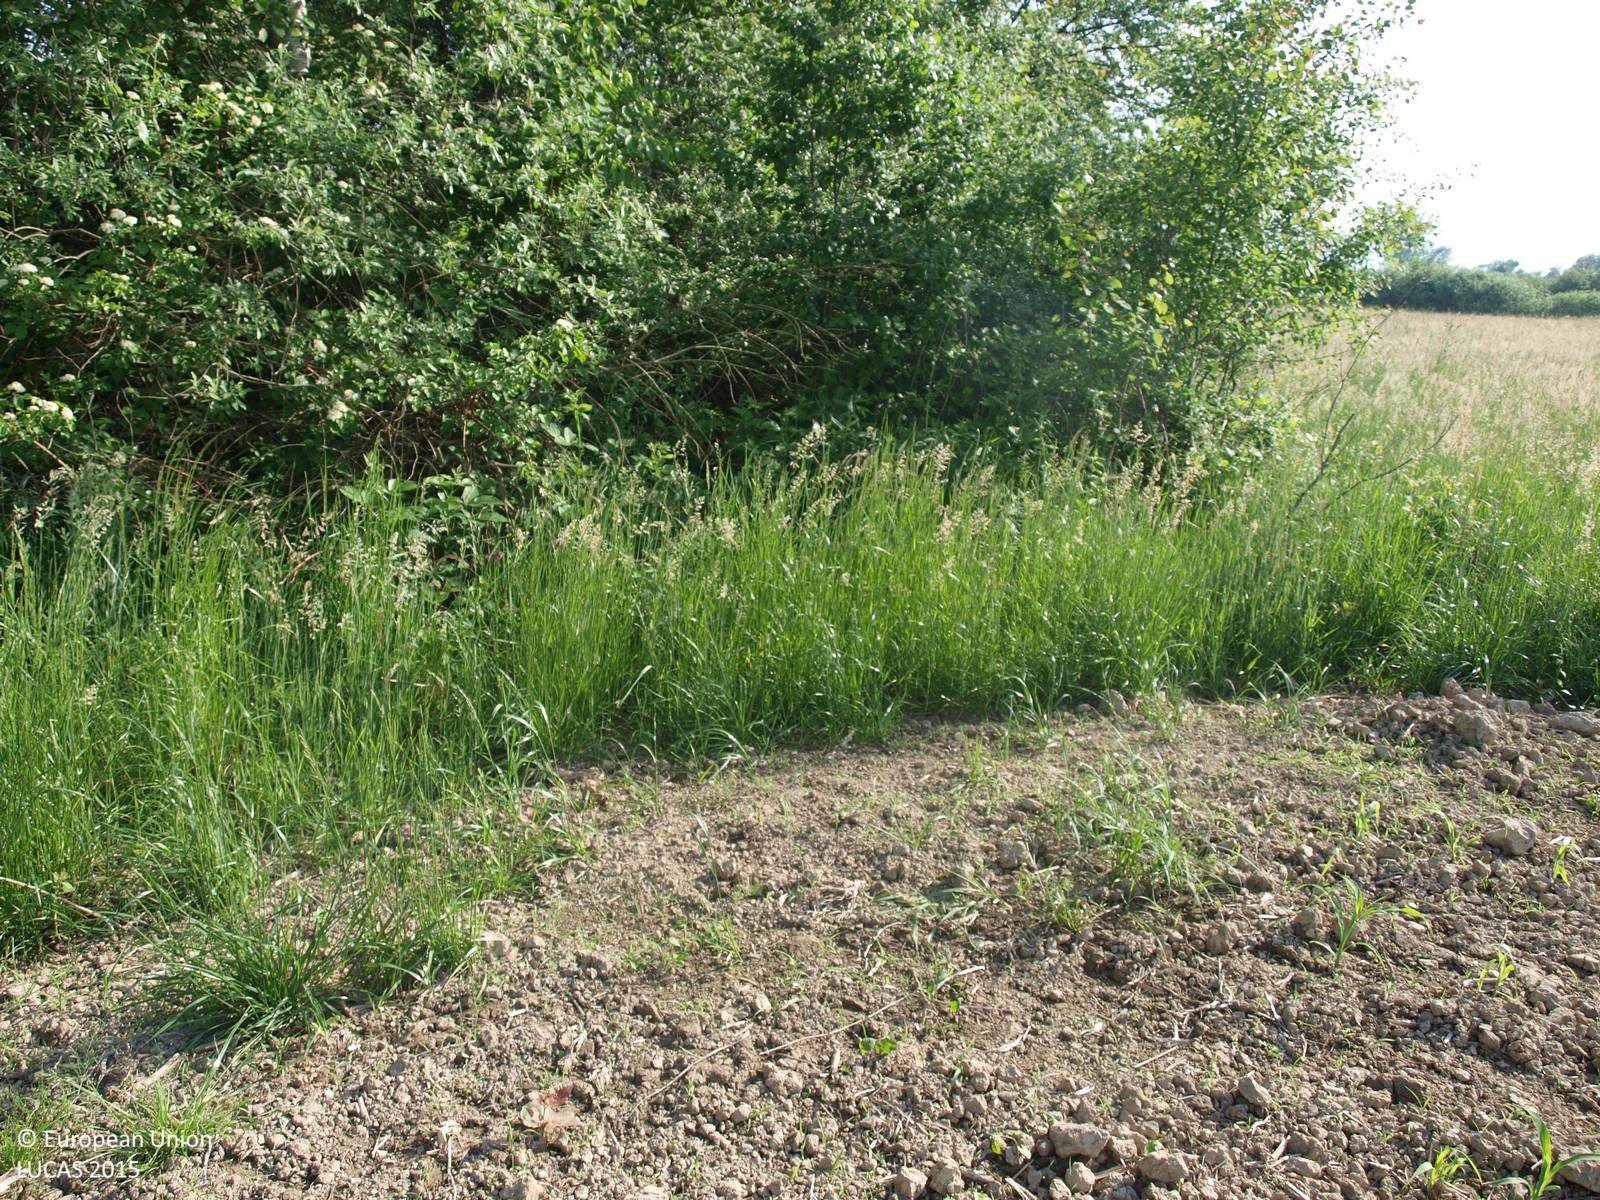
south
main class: Cropland
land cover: Maize
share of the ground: 25 - 50 %
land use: Agriculture (excluding fallow land and kitchen gardens)
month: May
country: HR
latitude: 46.2608
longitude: 16.2140
